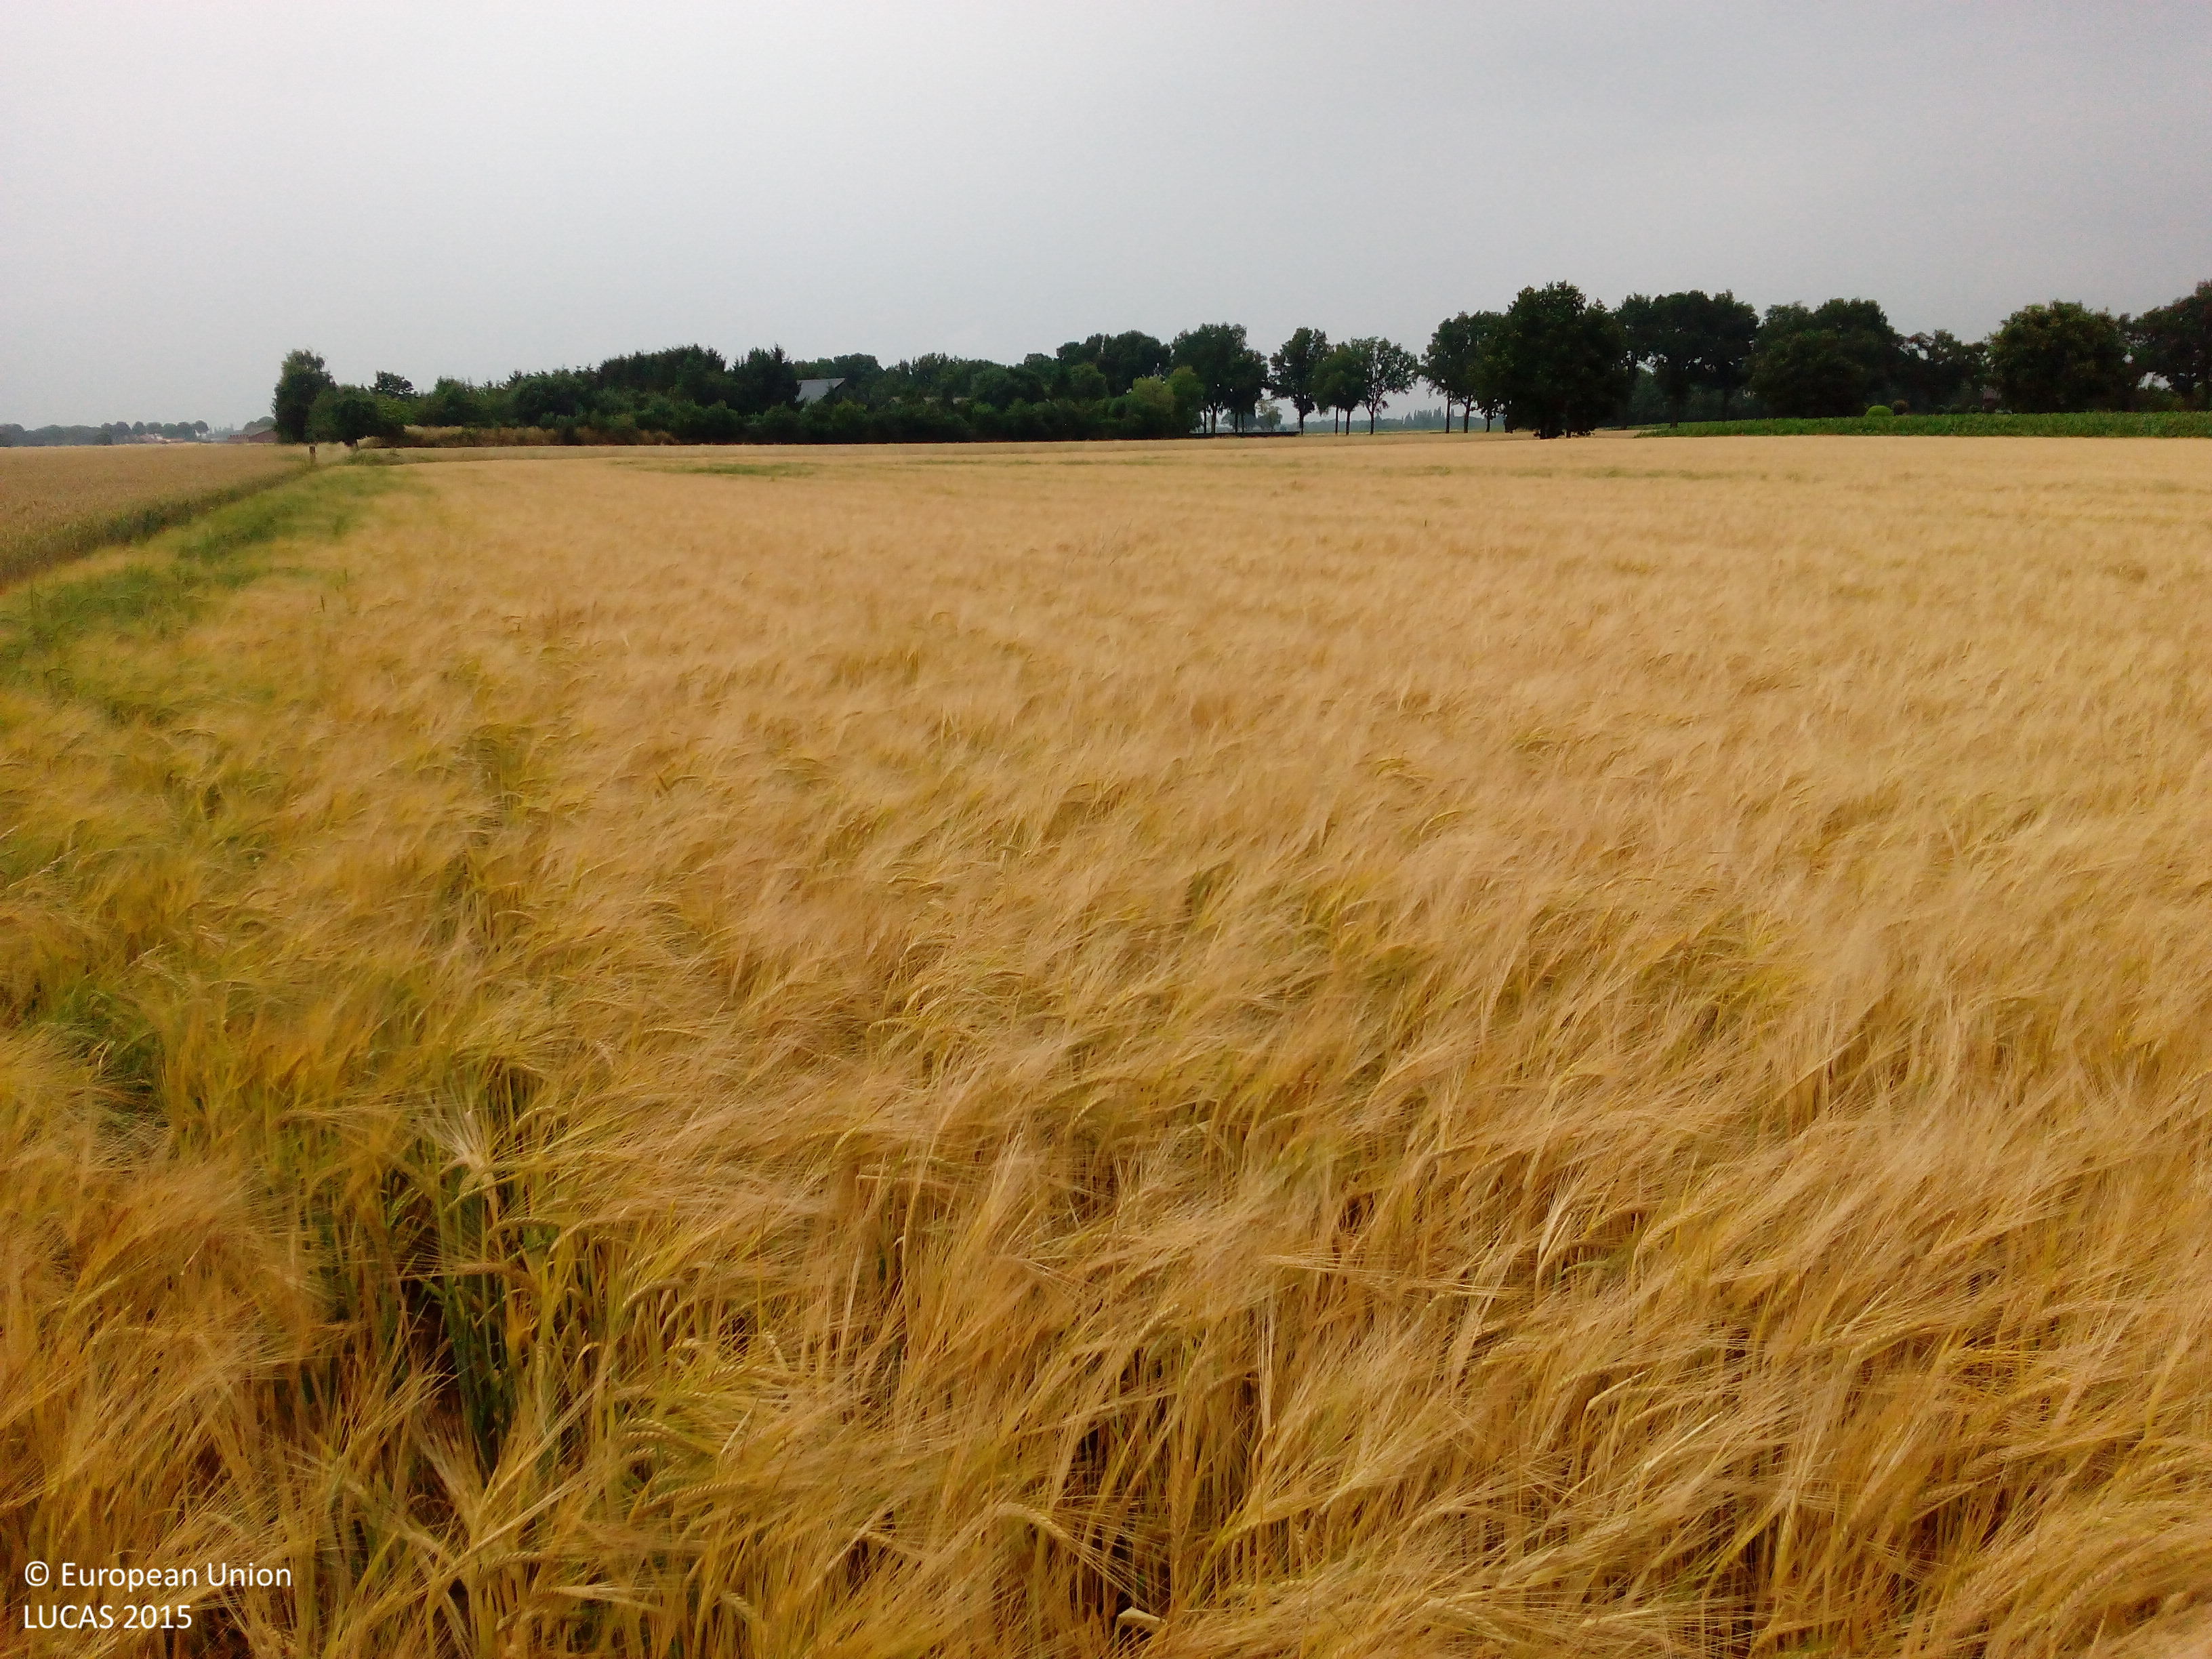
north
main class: Cropland
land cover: Barley
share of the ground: > 75 %
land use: Agriculture (excluding fallow land and kitchen gardens)
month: July
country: NL
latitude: 51.8878
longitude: 6.2944
